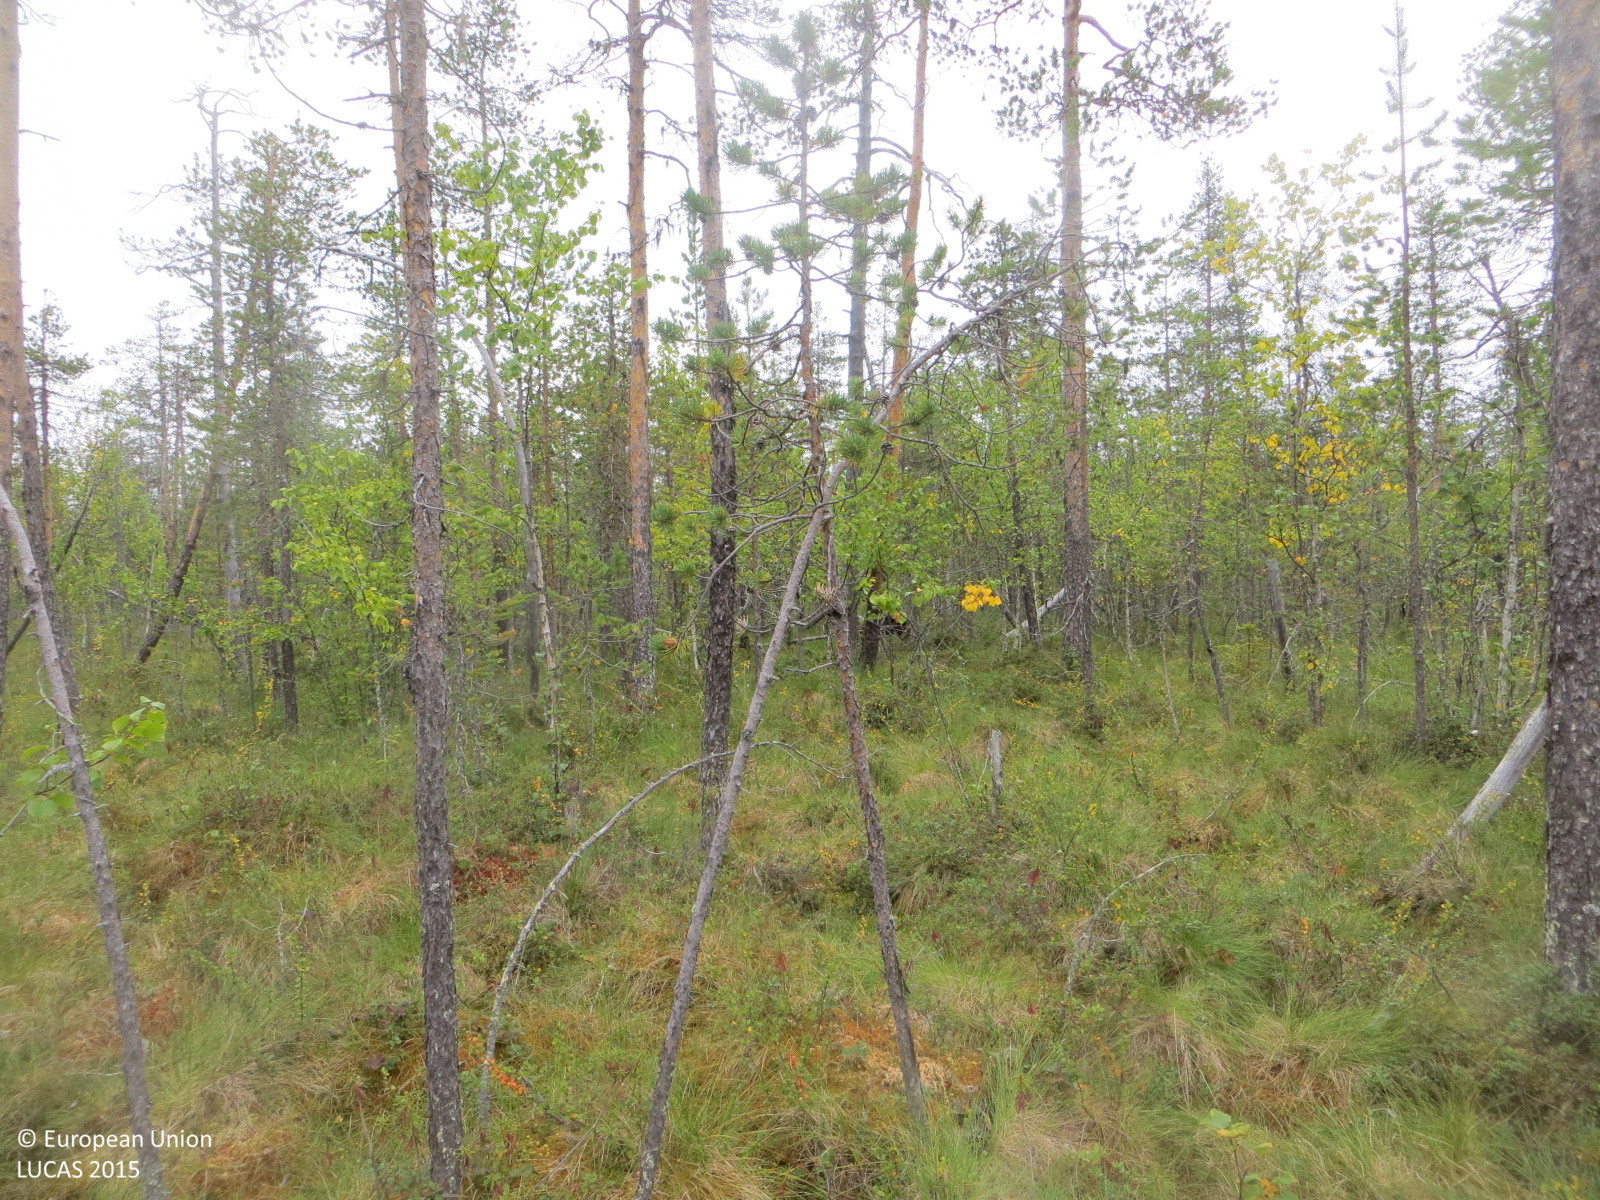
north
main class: Woodland
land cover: Pine dominated coniferous woodland
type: mire and swamp forests
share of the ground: 25 - 50 %
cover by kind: shrubs 50 %, coniferous forest trees 25 %, herbaceous plants 20 %, lichens and mosses 5 %
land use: Semi-natural and natural areas not in use
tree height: > 5 m
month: August
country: FI
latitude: 67.3997
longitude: 23.8497
